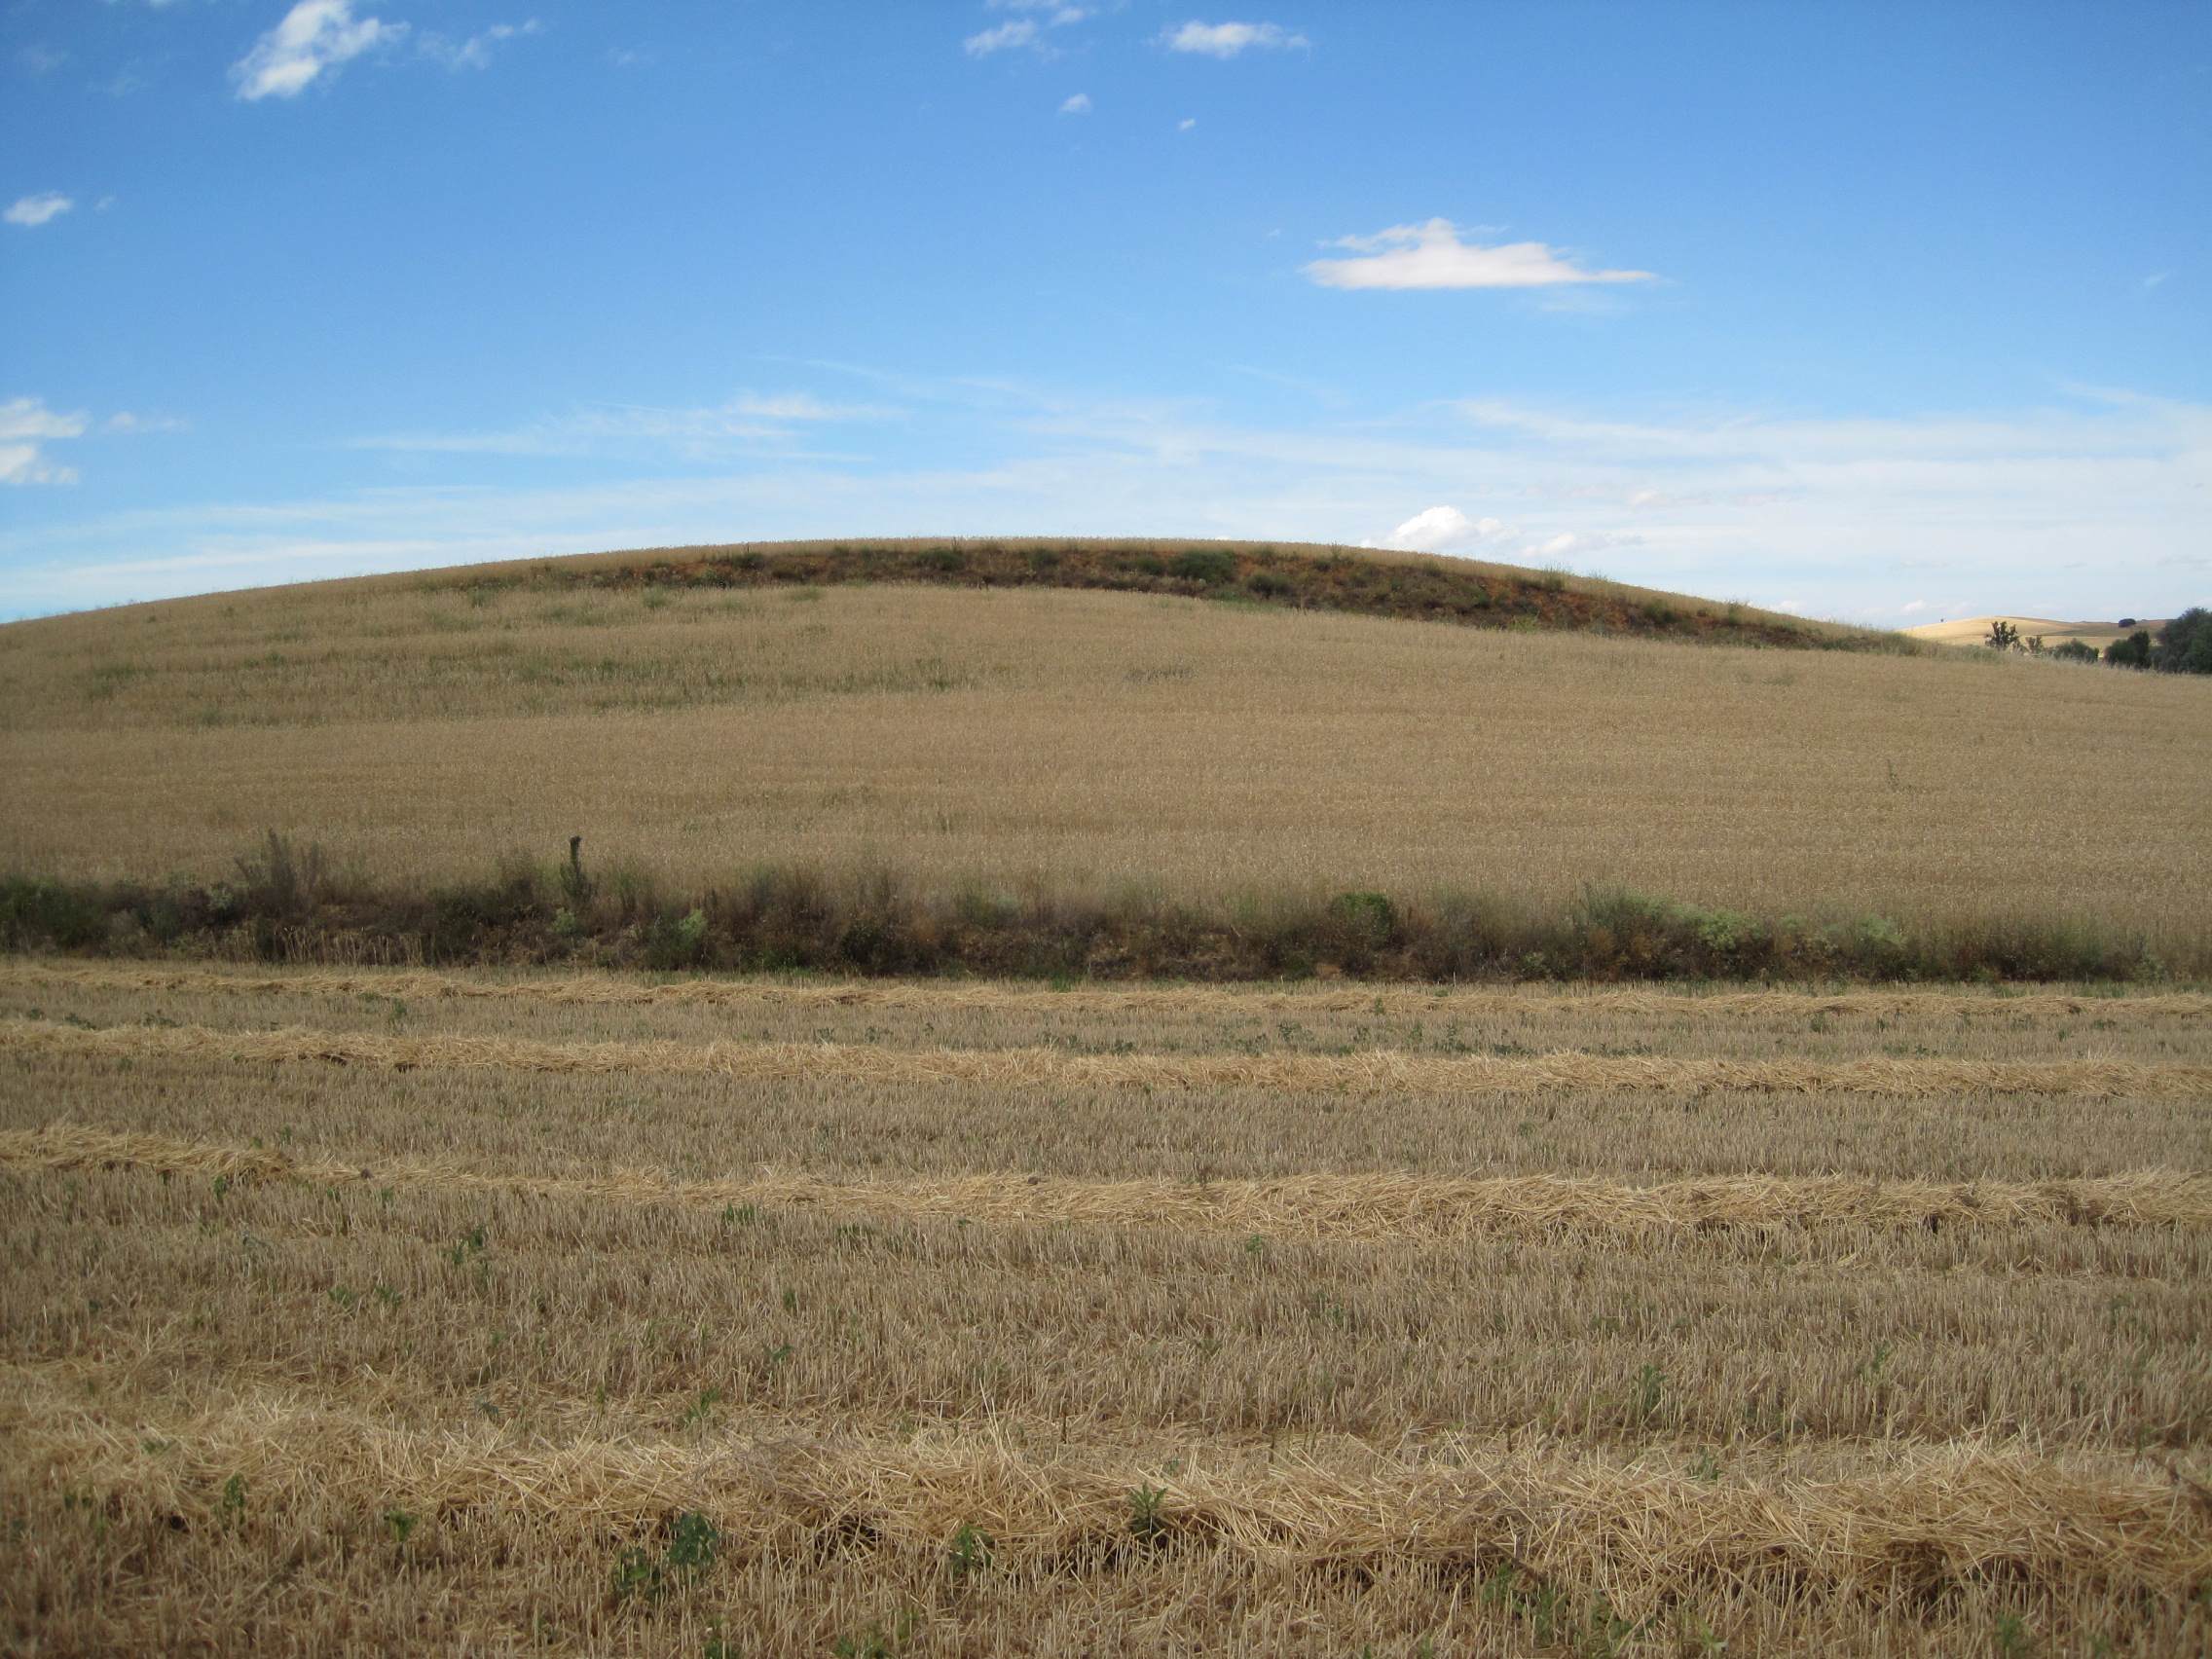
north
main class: Cropland
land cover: Common wheat
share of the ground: < 10 %
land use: Agriculture (excluding fallow land and kitchen gardens)
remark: Harvested field
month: July
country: ES
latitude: 42.1331
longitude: -5.4904
